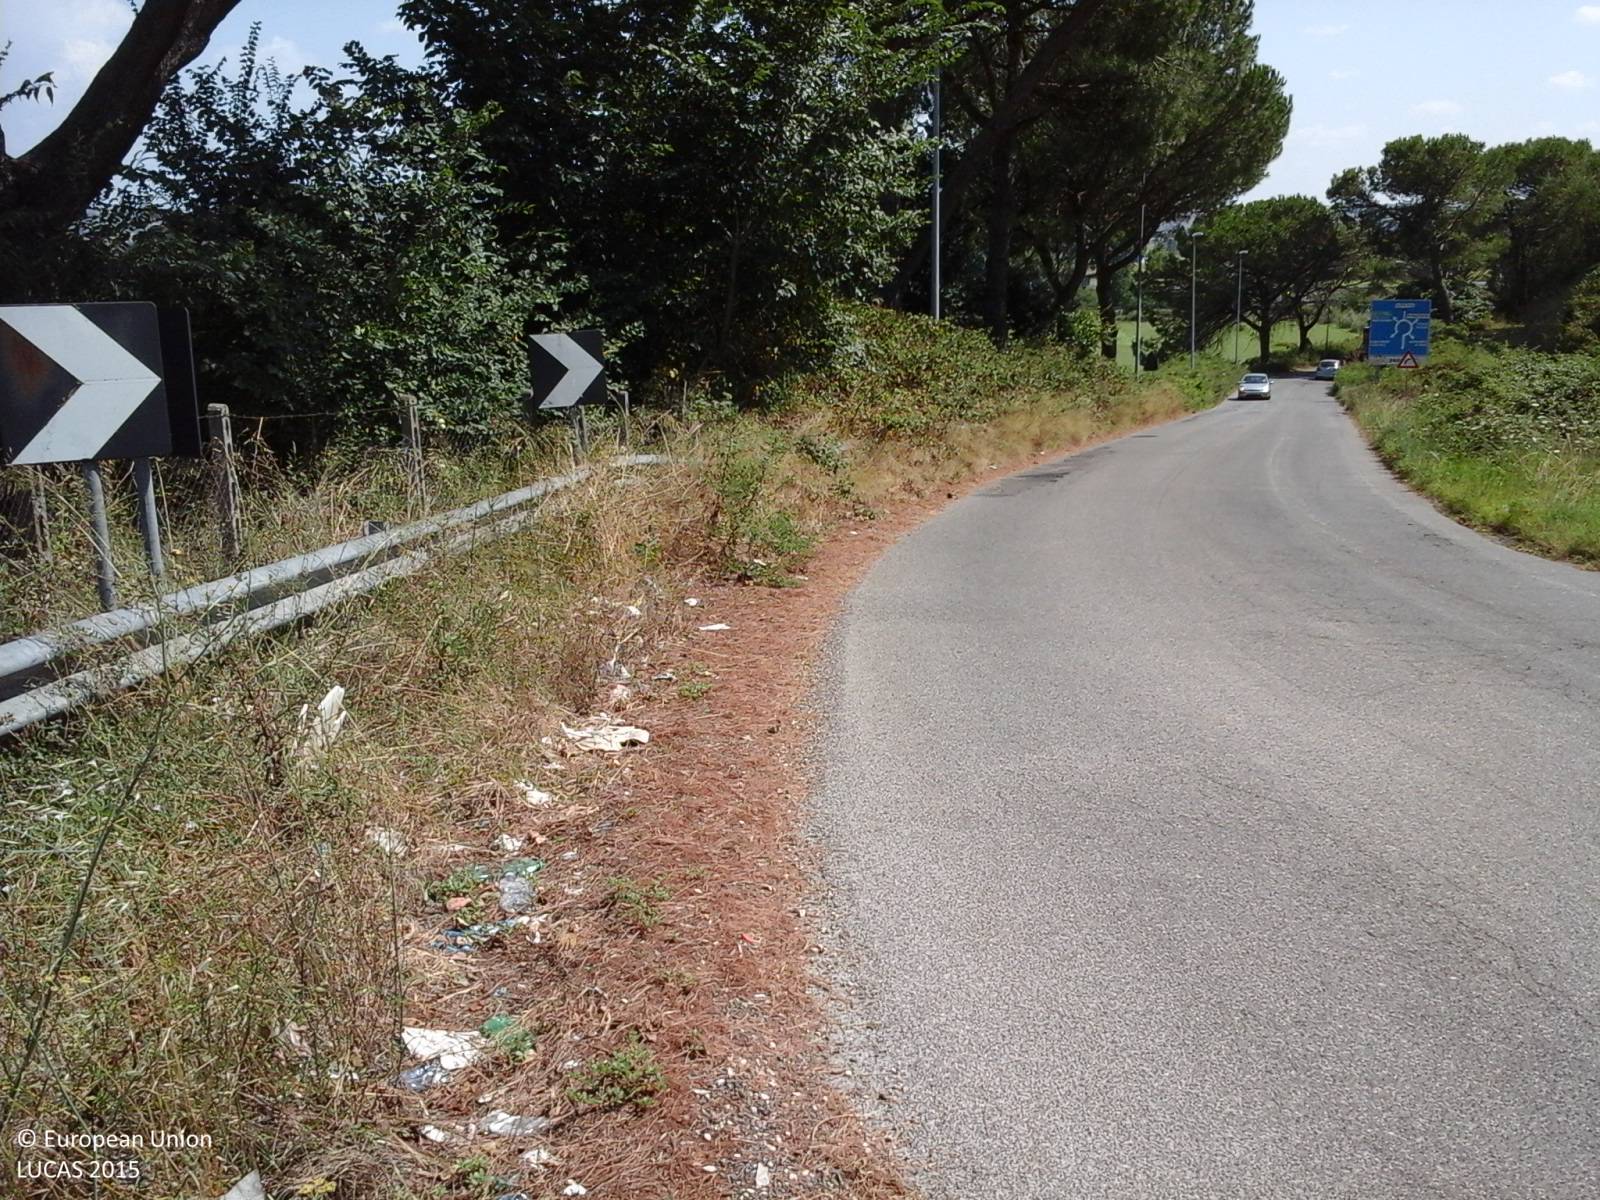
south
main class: Grassland
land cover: Grassland without tree/shrub cover
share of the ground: > 75 %
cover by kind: herbaceous plants 100 %
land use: Agriculture (excluding fallow land and kitchen gardens)
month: July
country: IT
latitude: 42.0974
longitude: 12.5663
